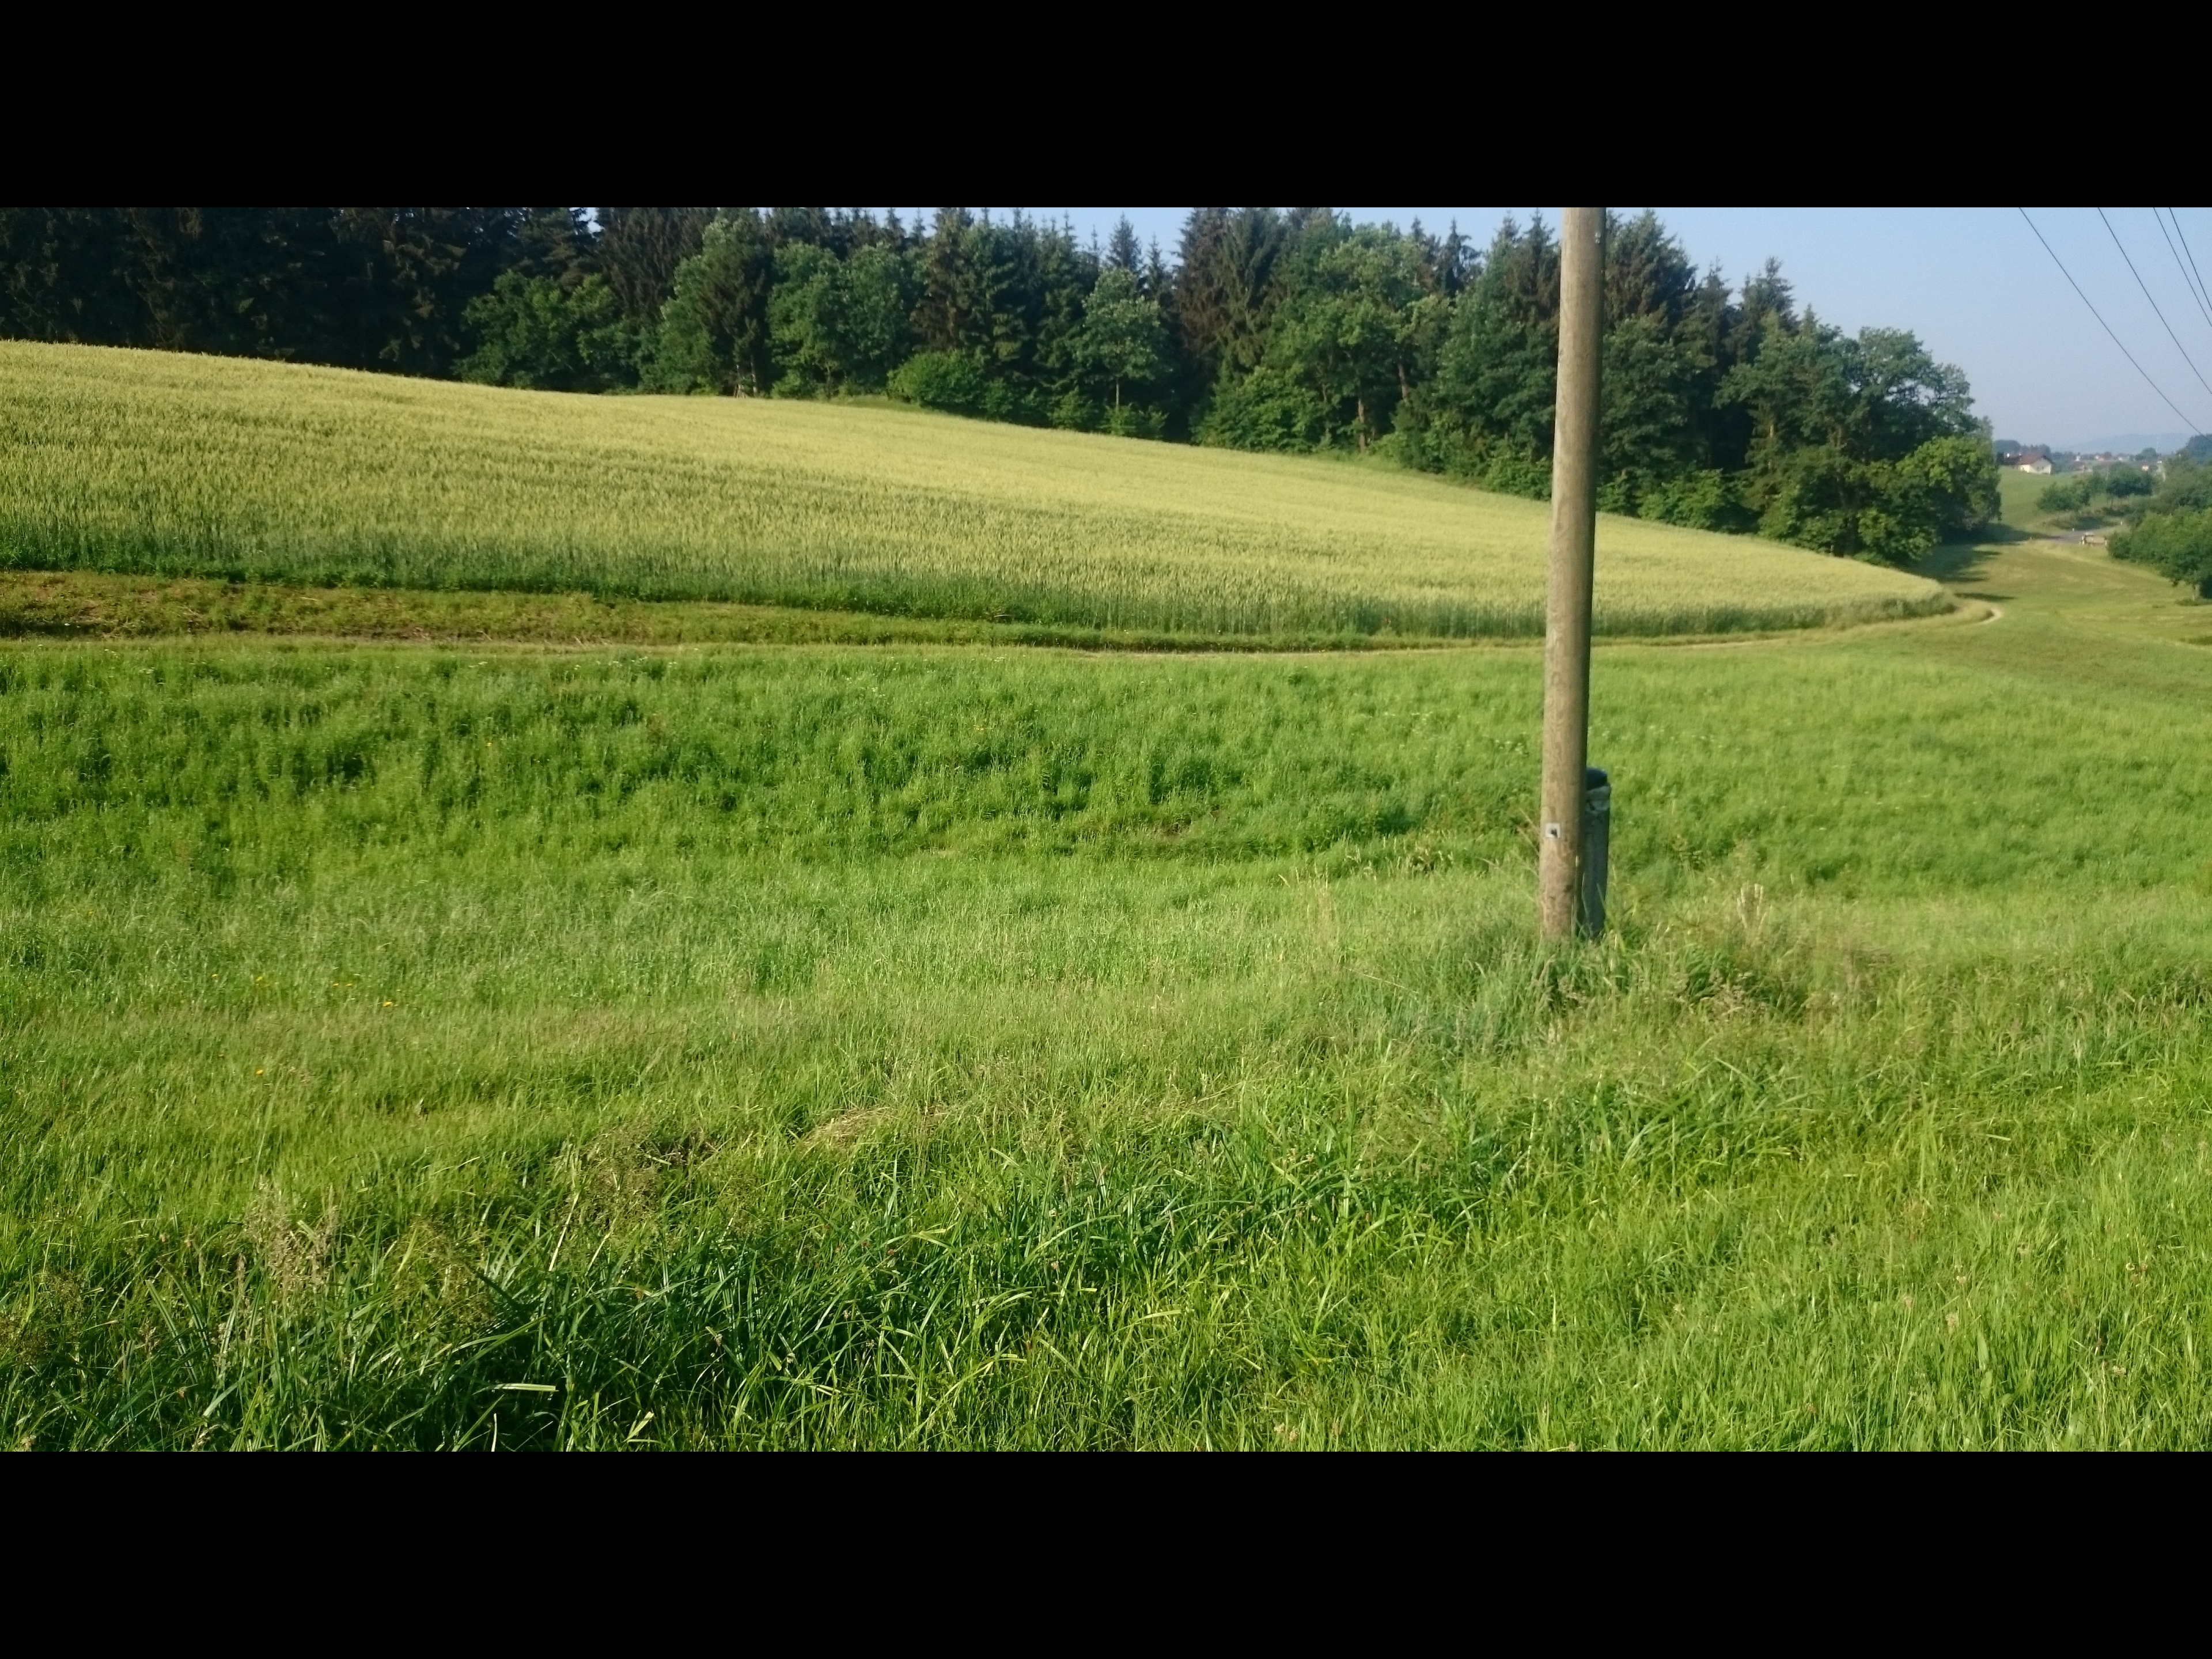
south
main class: Grassland
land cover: Grassland without tree/shrub cover
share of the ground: > 75 %
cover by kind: herbaceous plants 100 %
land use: Agriculture (excluding fallow land and kitchen gardens)
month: June
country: AT
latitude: 48.3819
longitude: 14.5509
